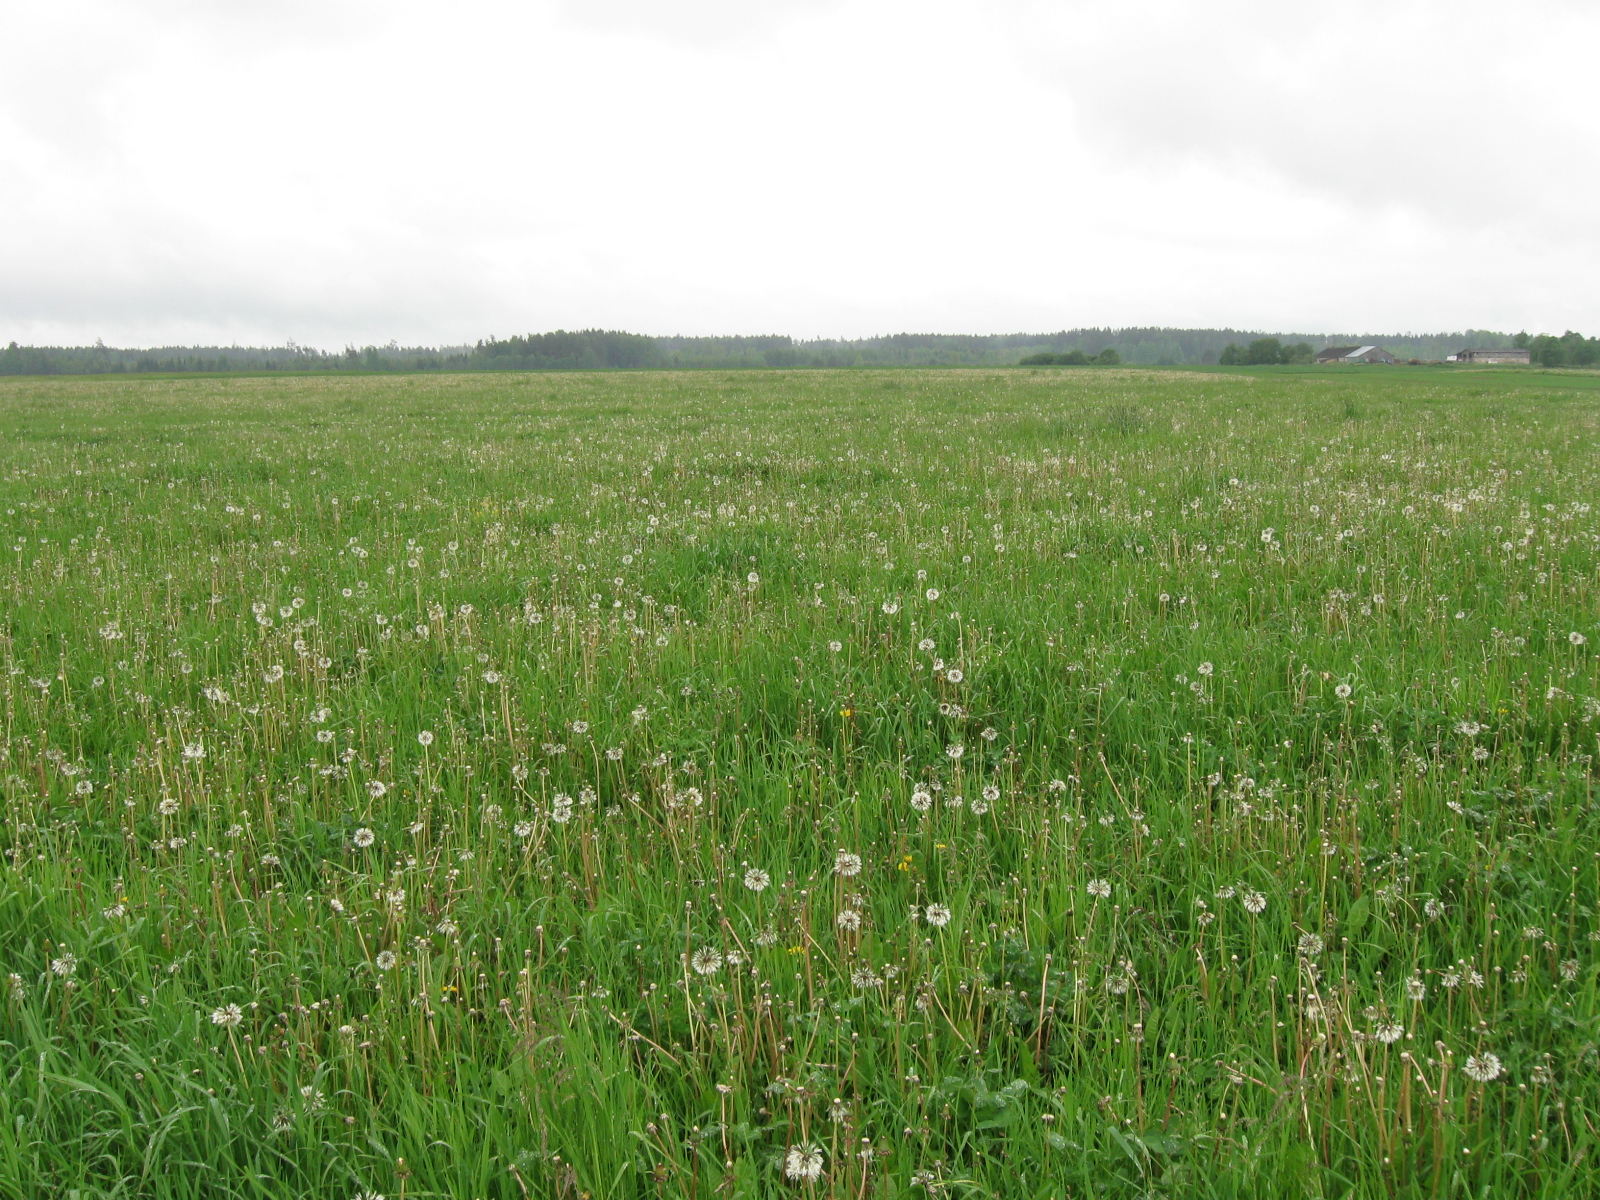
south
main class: Grassland
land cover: Grassland without tree/shrub cover
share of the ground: > 75 %
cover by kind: herbaceous plants 100 %
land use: Agriculture (excluding fallow land and kitchen gardens)
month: May
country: LT
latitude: 55.0166
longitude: 22.7822
